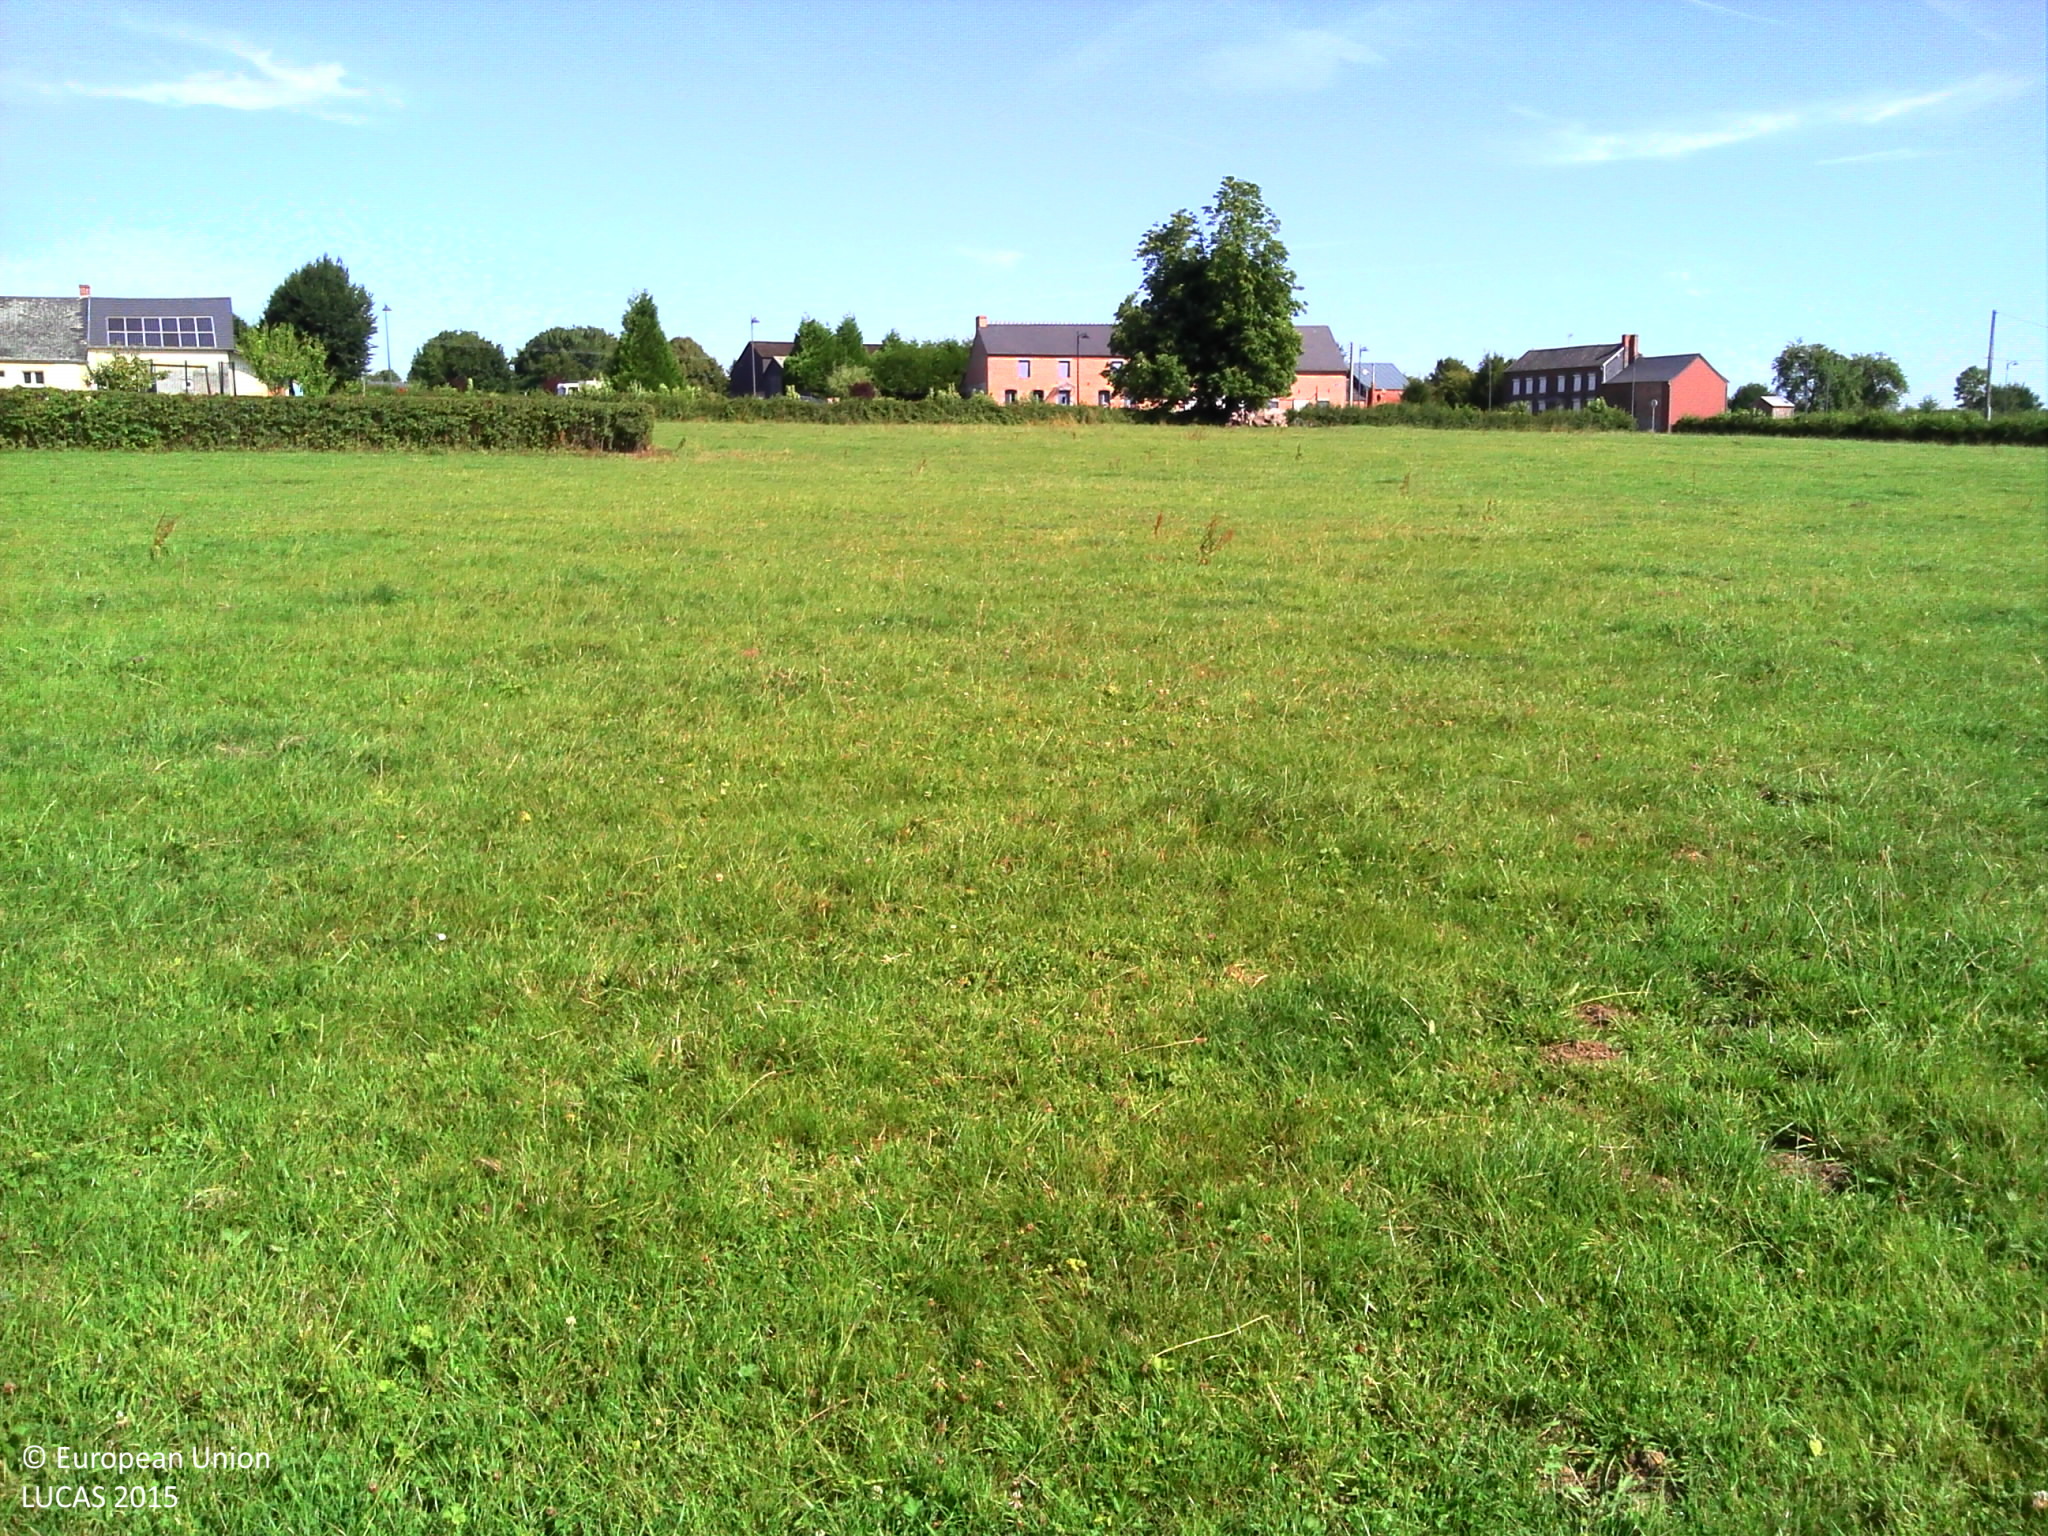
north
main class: Grassland
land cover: Grassland without tree/shrub cover
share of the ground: > 75 %
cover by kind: herbaceous plants 95 %, lichens and mosses 5 %
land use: Agriculture (excluding fallow land and kitchen gardens)
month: August
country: FR
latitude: 50.0818
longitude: 4.0272
